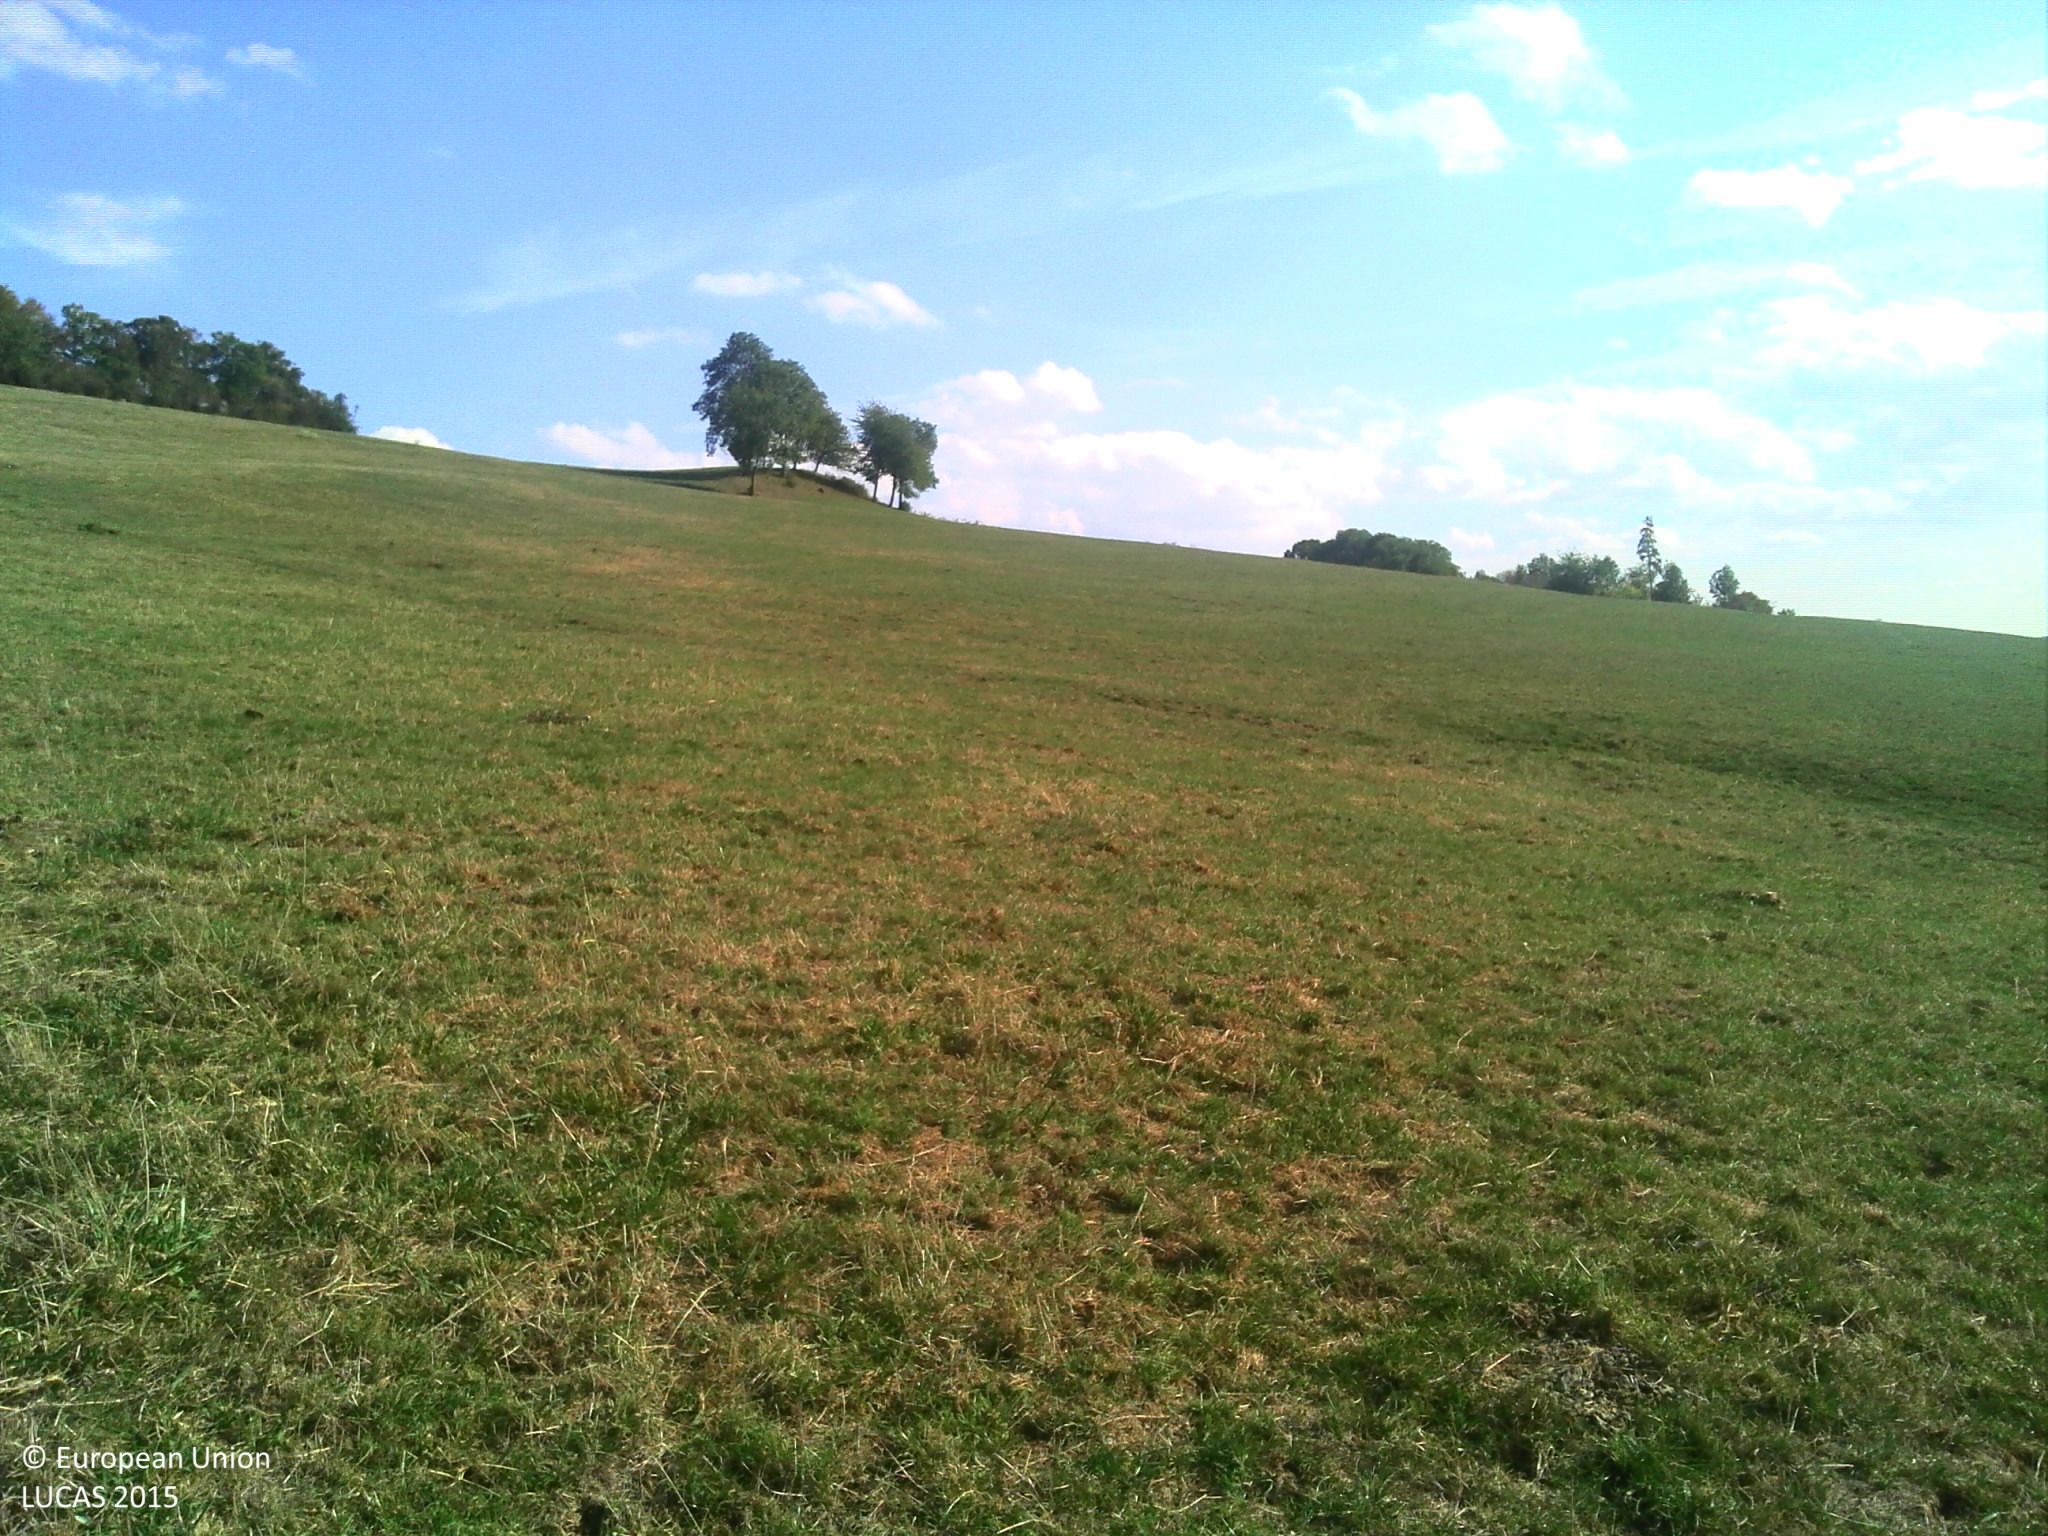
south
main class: Grassland
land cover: Grassland without tree/shrub cover
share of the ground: > 75 %
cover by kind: herbaceous plants 100 %
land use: Agriculture (excluding fallow land and kitchen gardens)
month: September
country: FR
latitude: 48.7867
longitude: 6.1481
